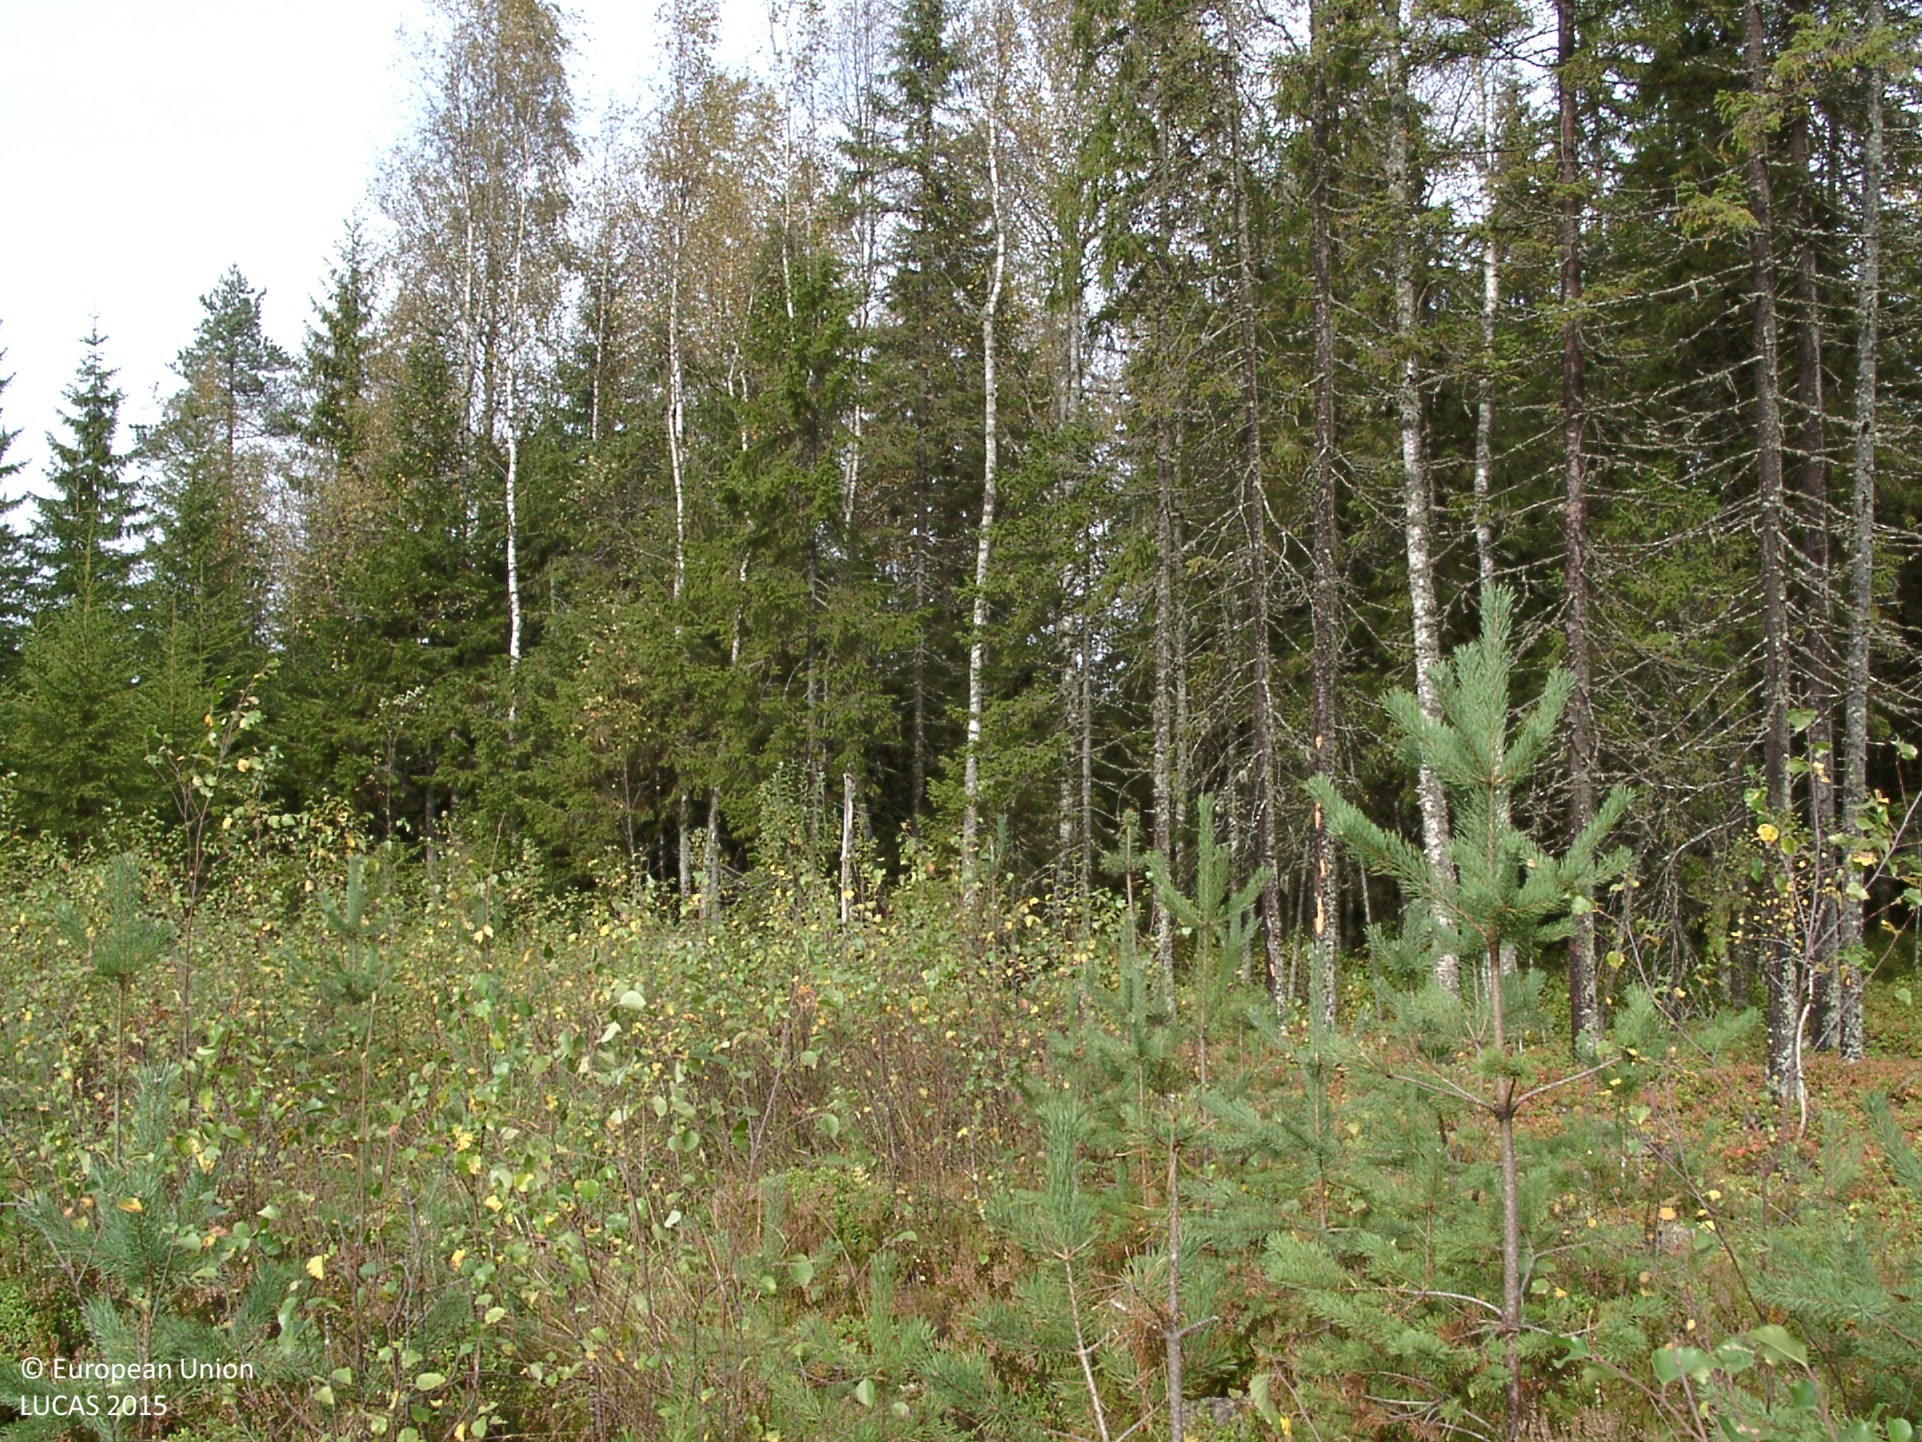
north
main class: Woodland
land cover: Pine dominated mixed woodland
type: boreal forest
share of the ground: 25 - 50 %
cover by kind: shrubs 50 %, broadleaved forest trees 20 %, coniferous forest trees 10 %, herbaceous plants 10 %, lichens and mosses 10 %
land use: Forestry
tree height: < 5 m
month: September
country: FI
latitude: 62.7221
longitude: 25.7022
